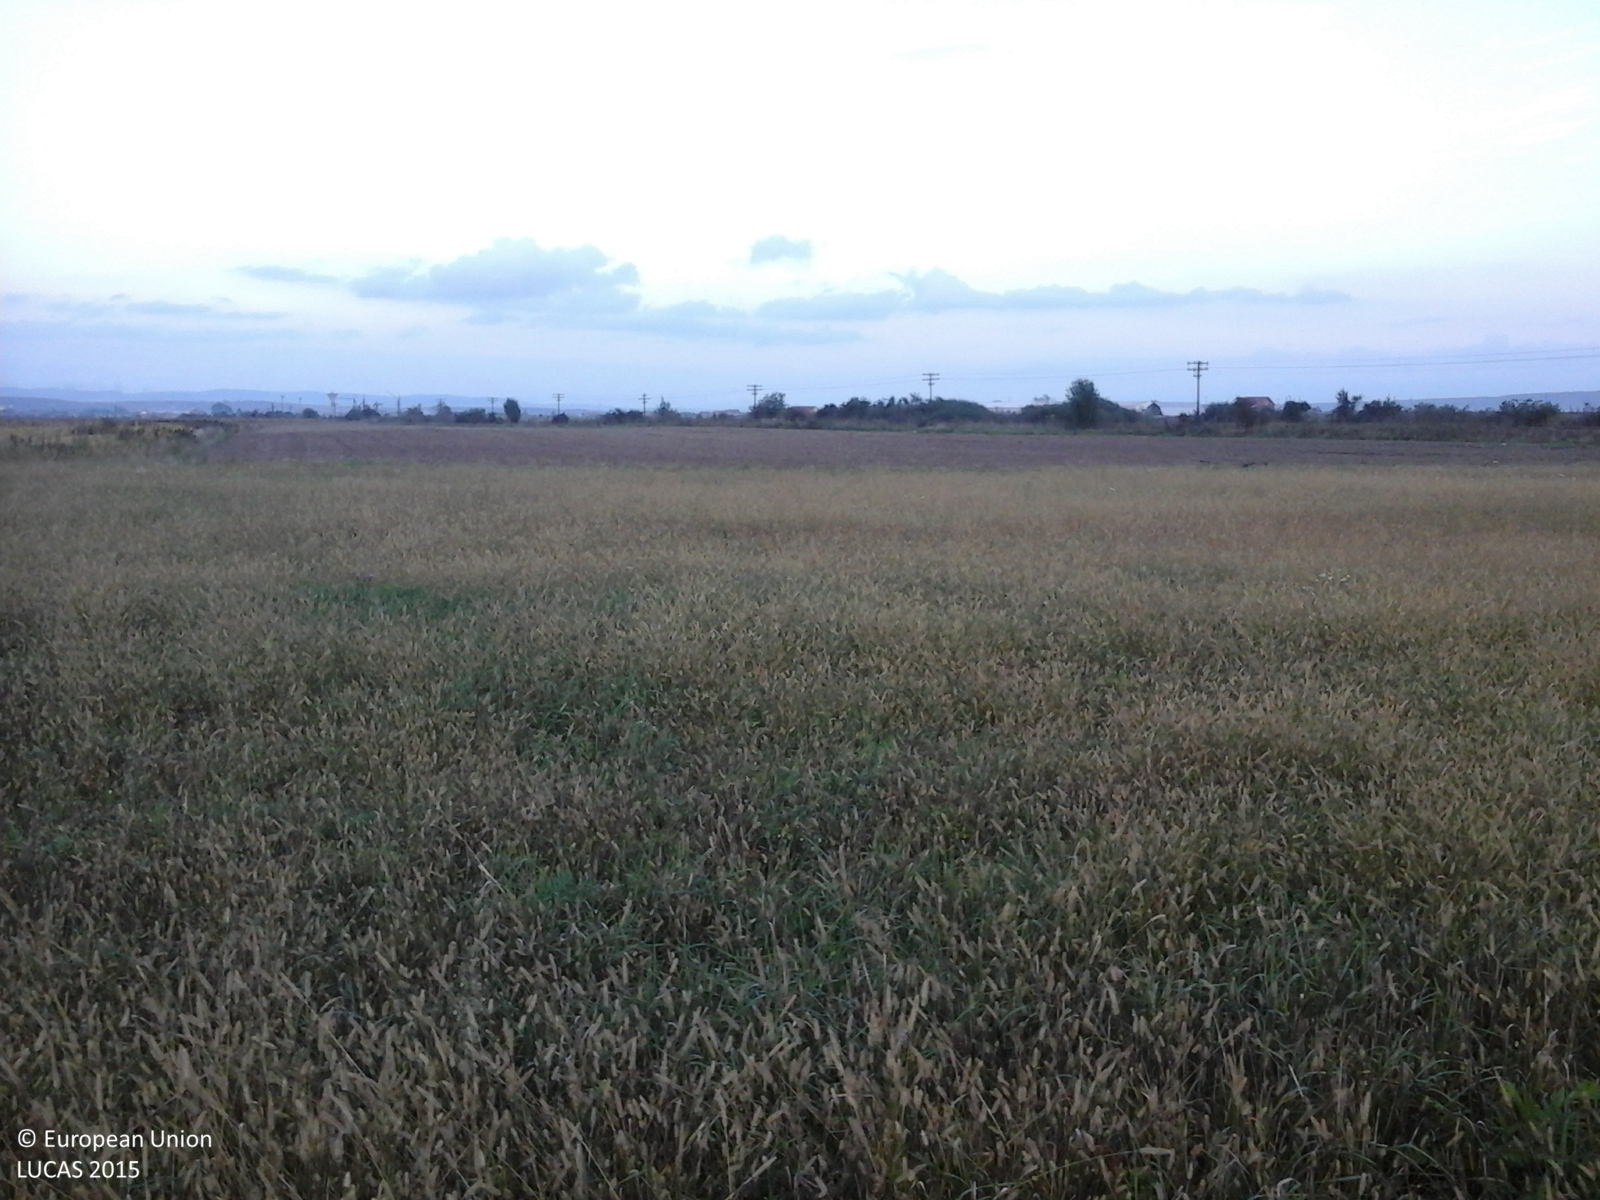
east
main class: Grassland
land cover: Grassland without tree/shrub cover
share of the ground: > 75 %
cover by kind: herbaceous plants 100 %
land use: Agriculture (excluding fallow land and kitchen gardens)
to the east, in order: Grassland without tree/shrub cover; Other bare soil; Grass margins; Tracks; Grass margins; Railways; Spontaneously vegetated surfaces; Shrubland with sparse tree cover; Electric lines; Shrubland with sparse tree cover; Ditches and canals; Grassland without tree/shrub cover
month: October
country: RO
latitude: 45.7722
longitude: 23.9990
